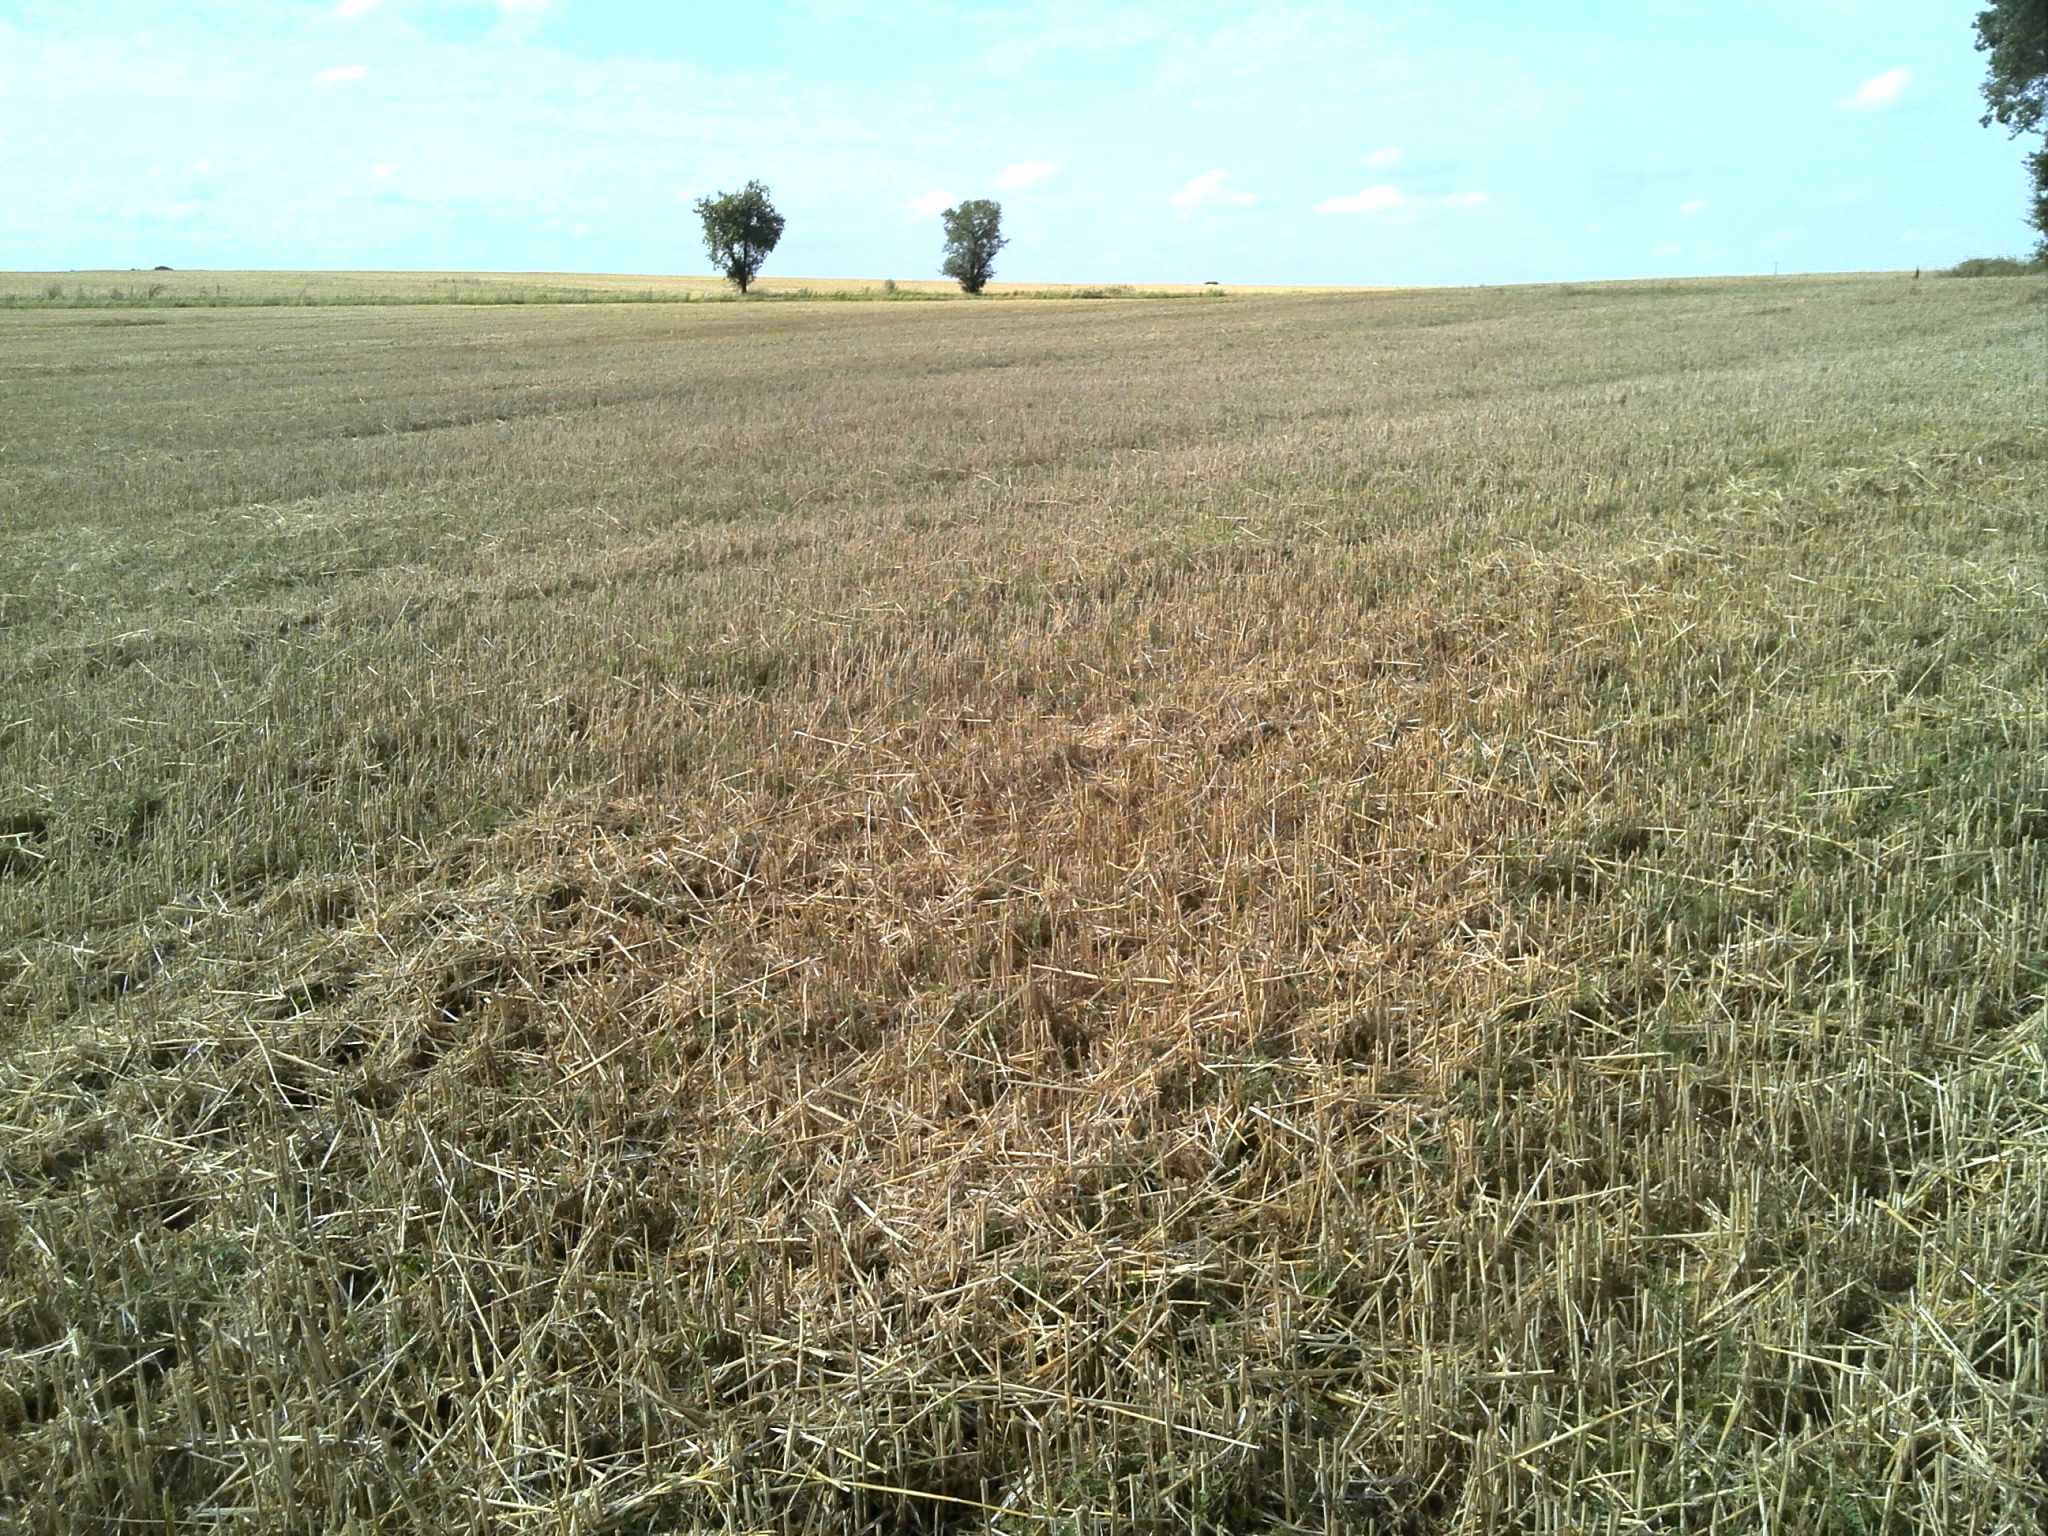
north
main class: Cropland
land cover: Common wheat
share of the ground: > 75 %
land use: Agriculture (excluding fallow land and kitchen gardens)
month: July
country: FR
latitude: 46.6826
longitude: 1.5040
